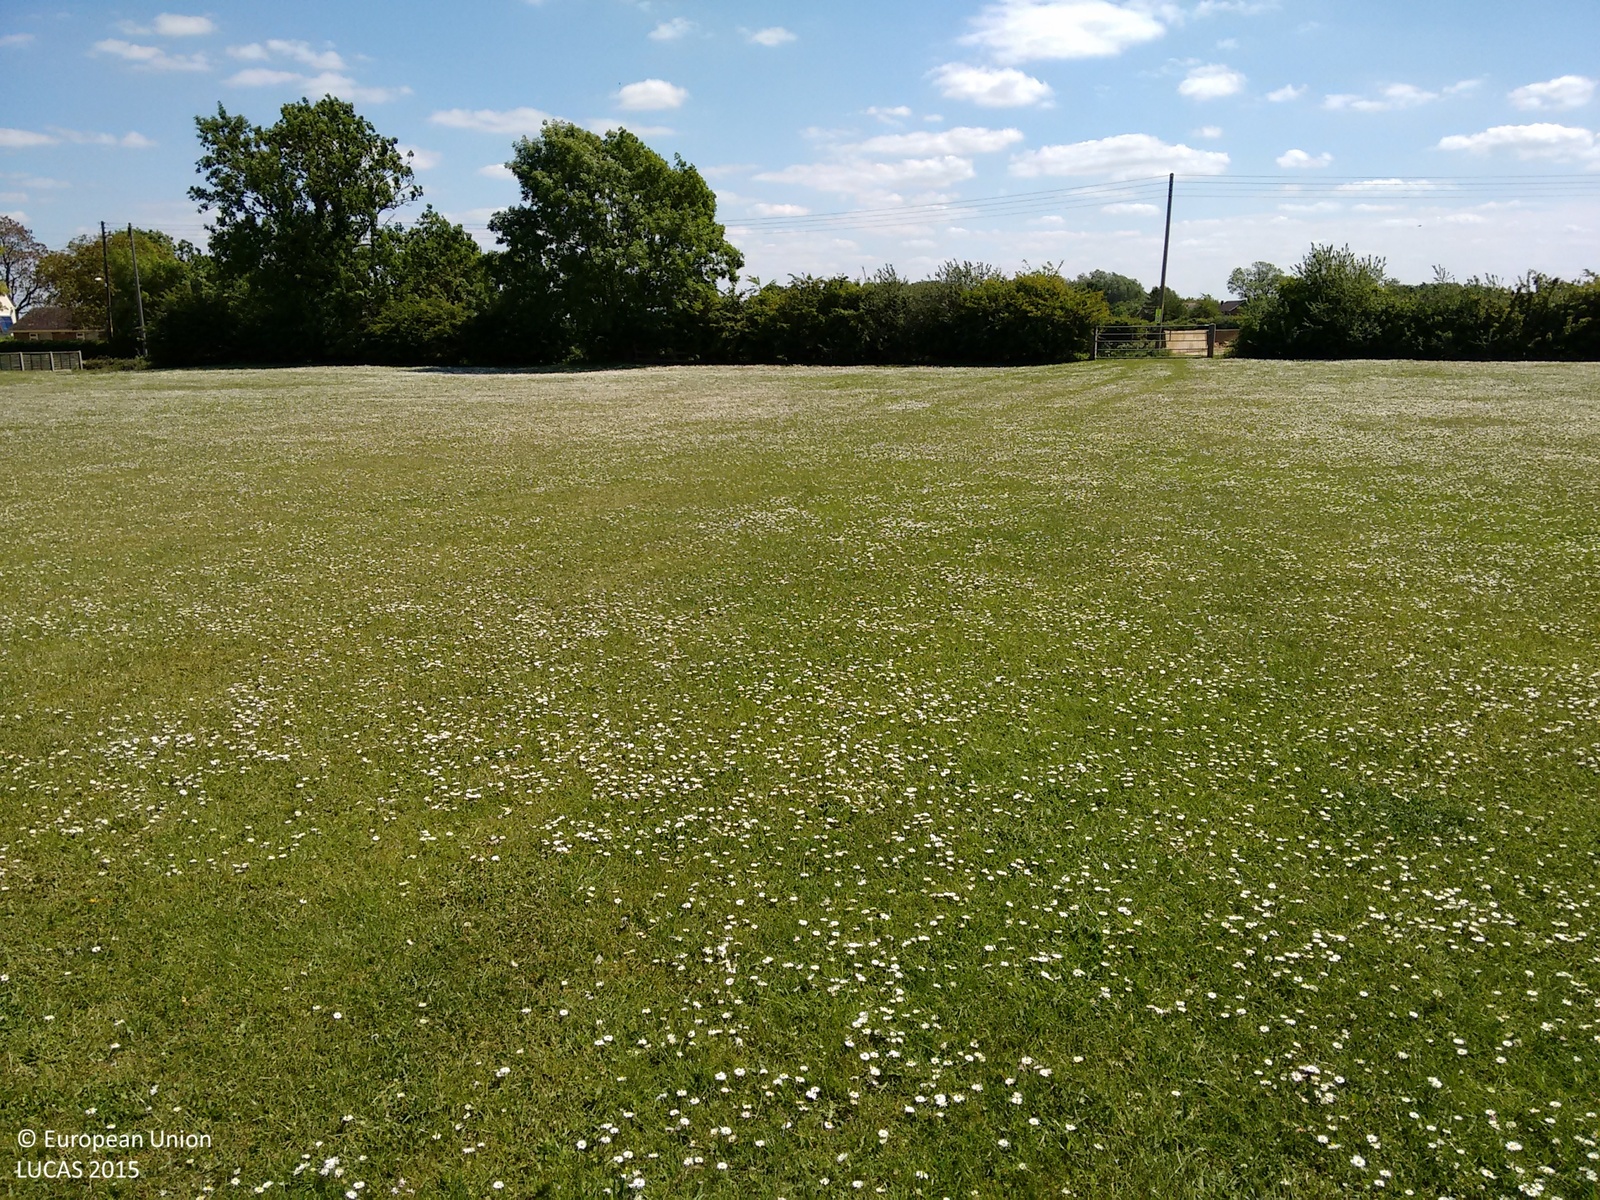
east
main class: Grassland
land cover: Grassland without tree/shrub cover
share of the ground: > 75 %
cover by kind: herbaceous plants 100 %
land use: Sport
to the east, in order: Grassland without tree/shrub cover; Managed hedges; Ditches and canals; Grass margins; Paved roads, cycling and walking lanes; Grass margins; Electric lines; Managed hedges; Grassland without tree/shrub cover
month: June
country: GB
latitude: 52.6601
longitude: -0.4308
